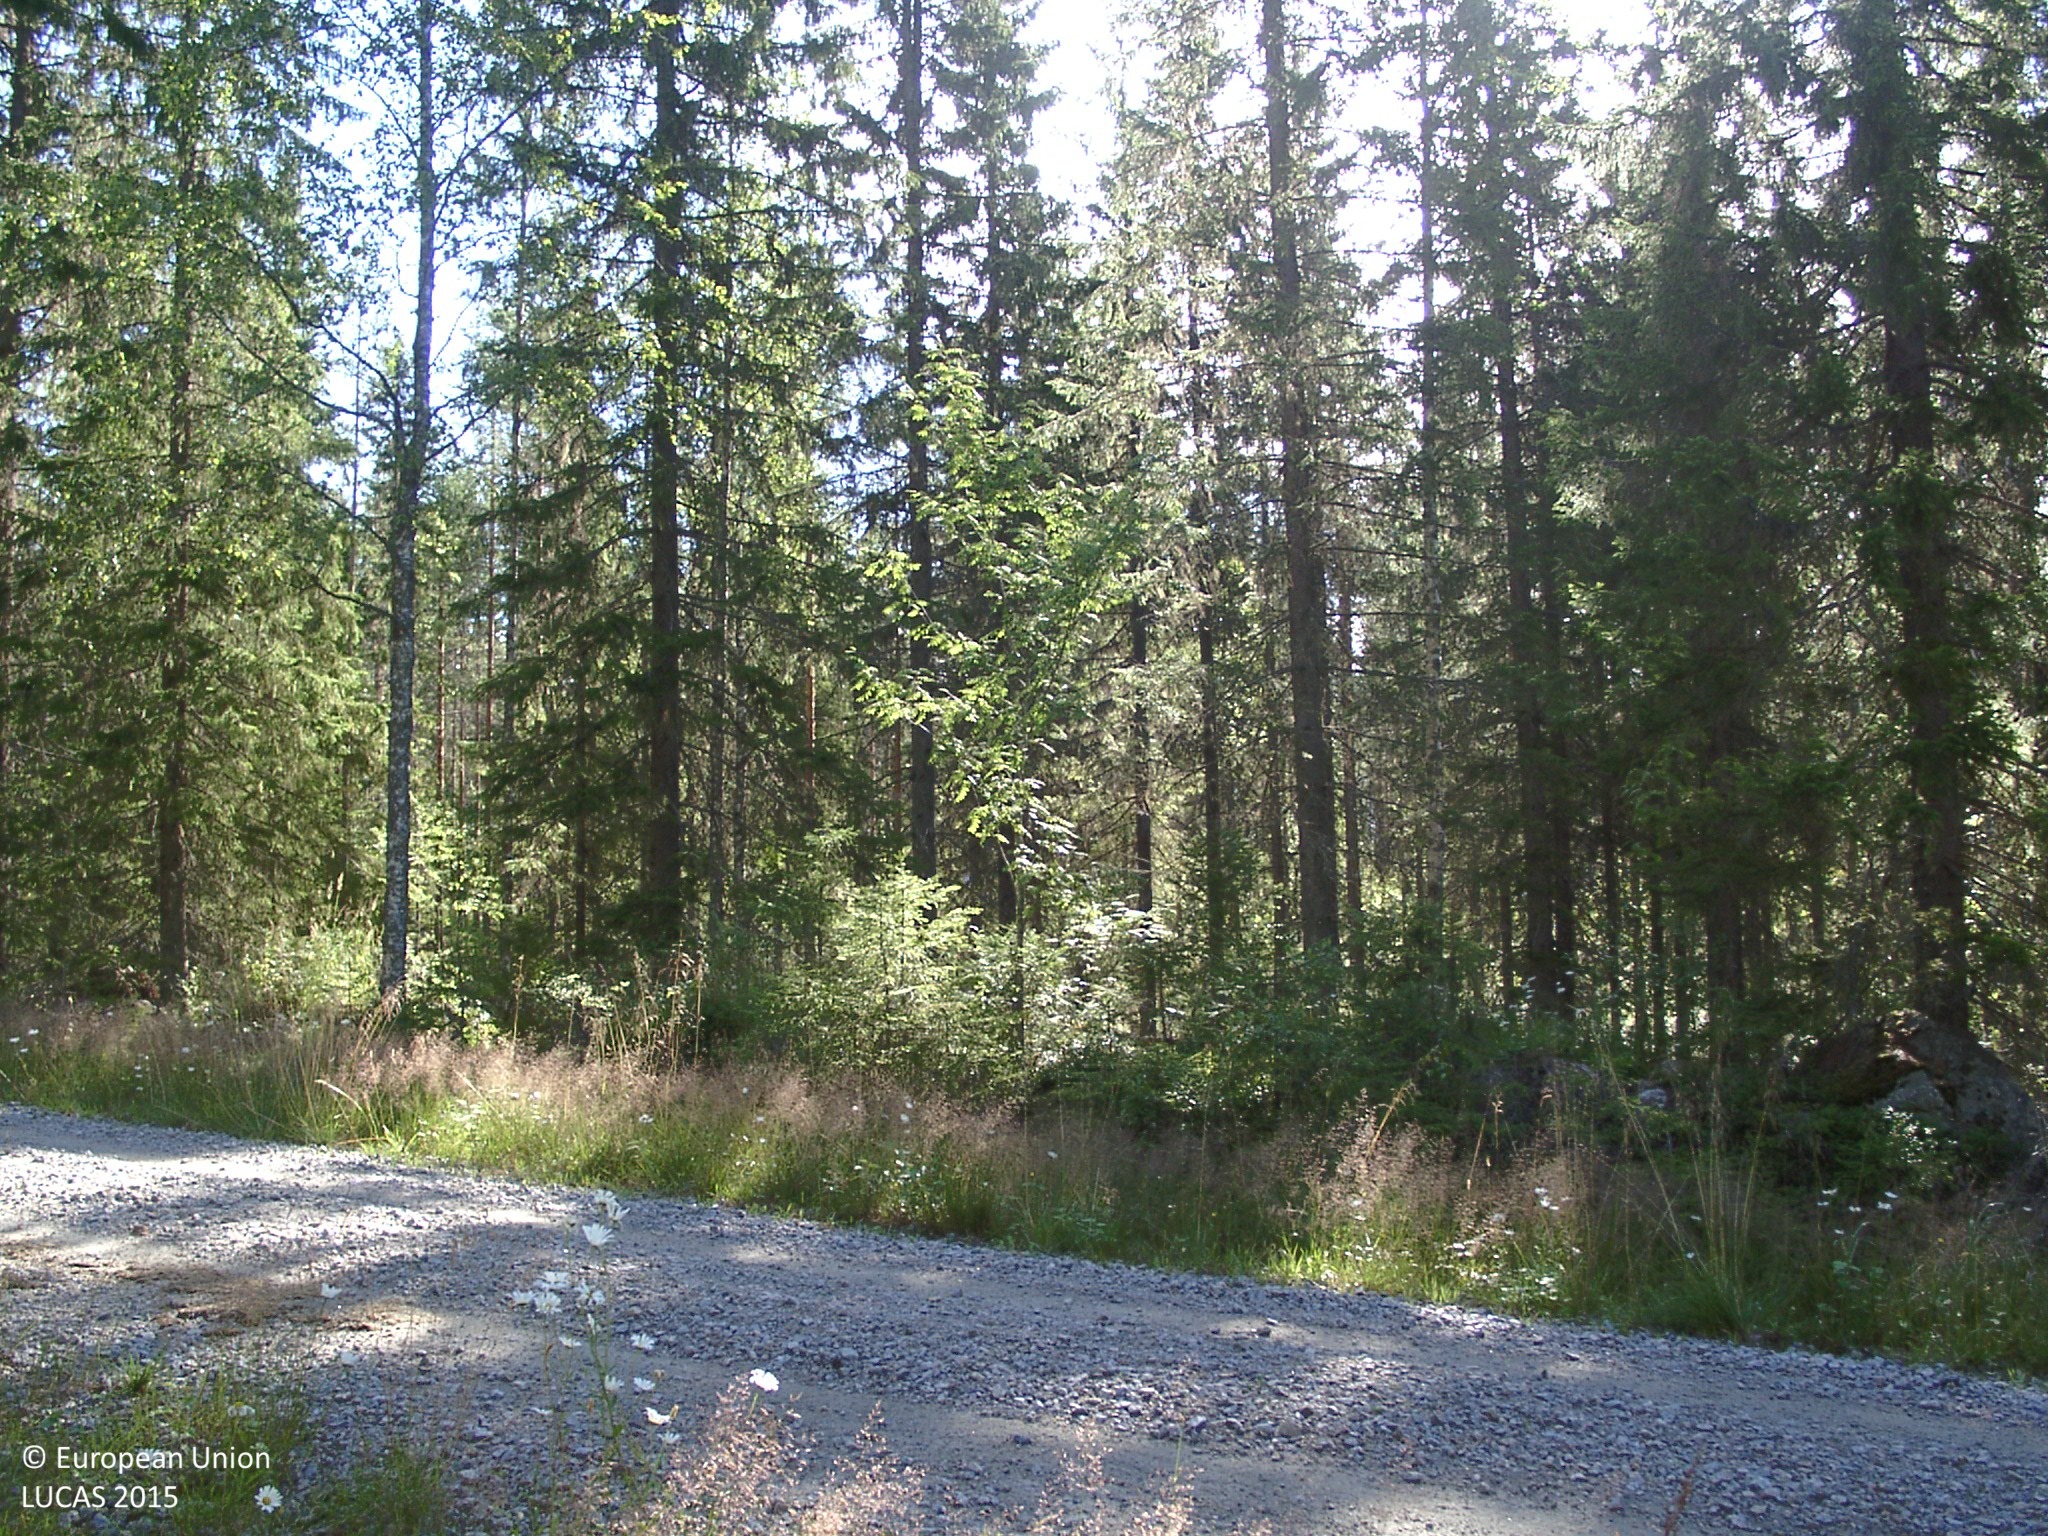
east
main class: Woodland
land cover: Other mixed woodland
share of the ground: 50 - 75 %
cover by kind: coniferous forest trees 45 %, shrubs 25 %, broadleaved forest trees 20 %, herbaceous plants 10 %
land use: Forestry
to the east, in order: Ditches and canals; Grass margins; Tracks; Grass margins; Ditches and canals; Spruce dominated mixed woodland; Other coniferous woodland; Tracks; Pine dominated coniferous woodland; Tracks; Other coniferous woodland; Tracks; Other coniferous woodland; Electric lines; Shrubland with sparse tree cover; Pine dominated coniferous woodland; Tracks; Pine dominated coniferous woodland; Tracks; Pine dominated coniferous woodland; Tracks; Pine dominated mixed woodland
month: August
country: FI
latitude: 62.3683
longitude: 25.2008
